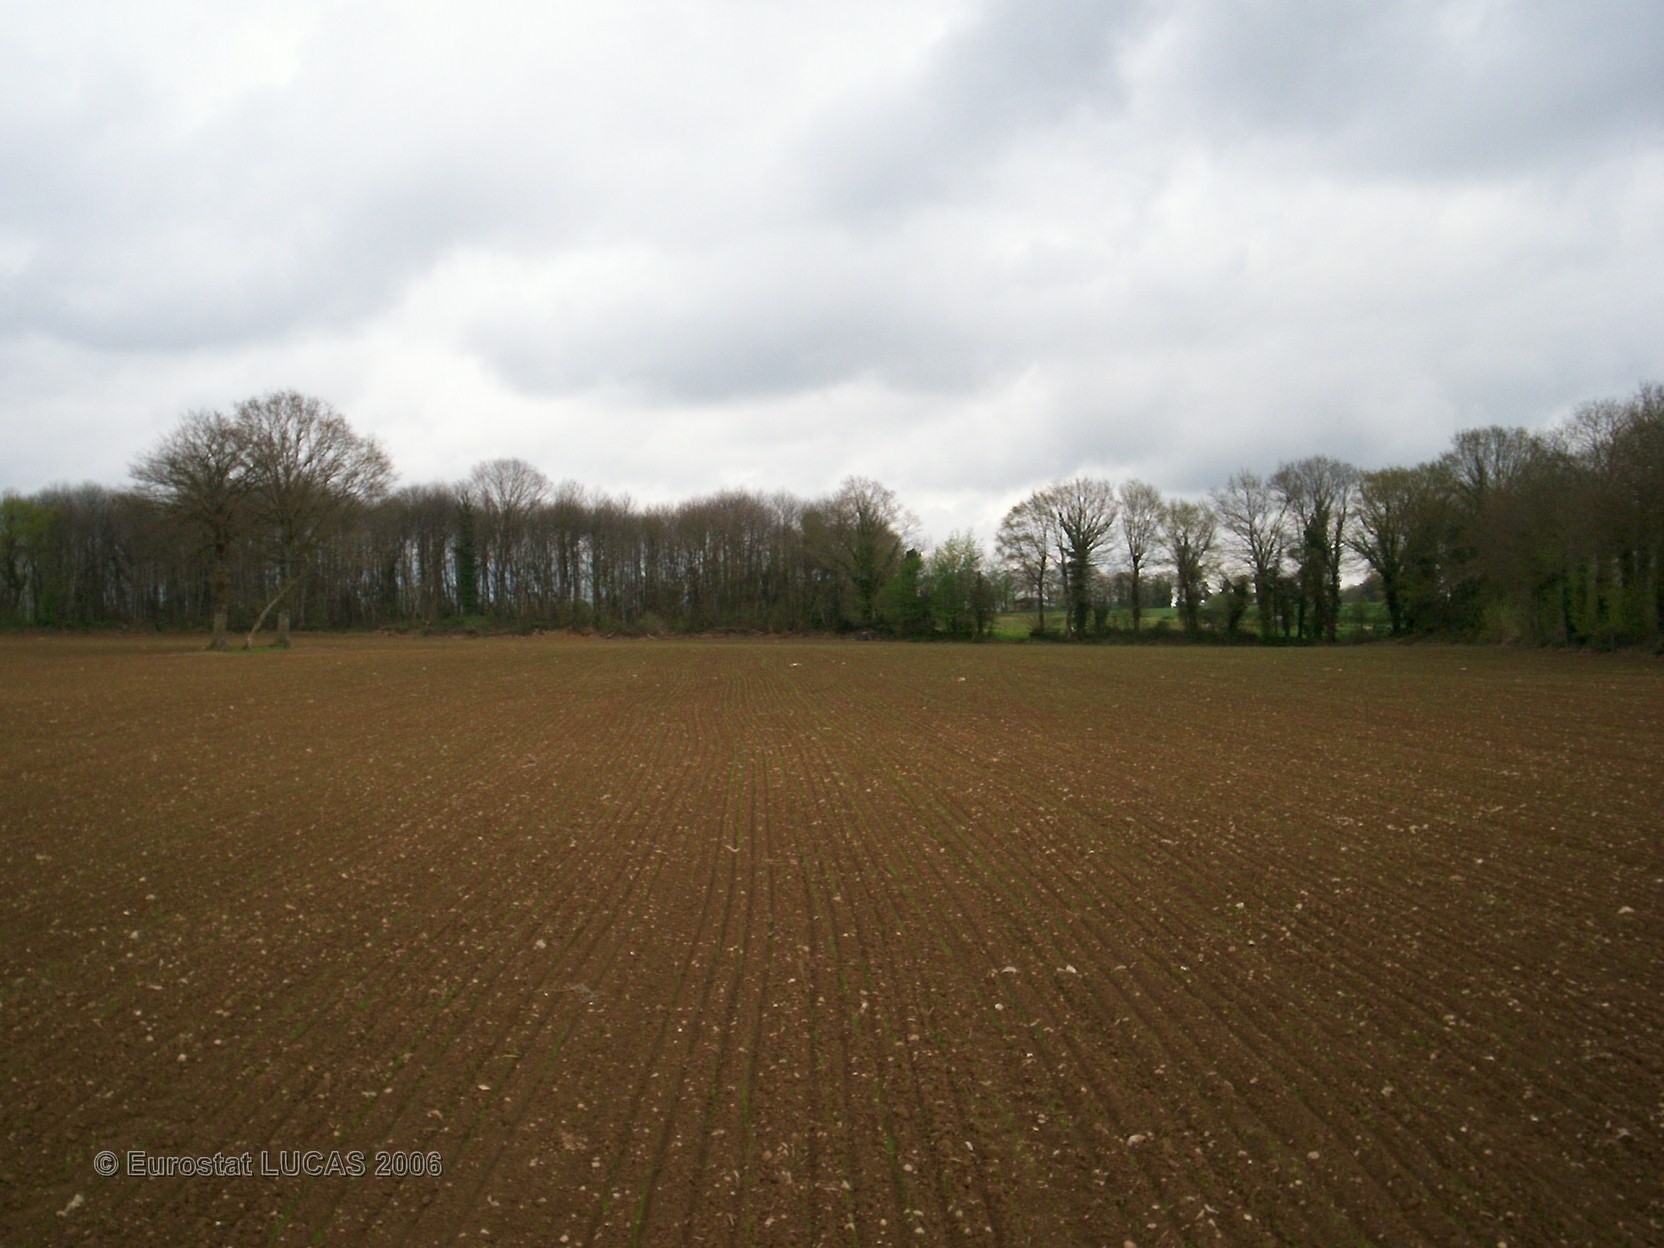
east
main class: Grassland
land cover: Grassland without tree/shrub cover
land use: Agriculture (excluding fallow land and kitchen gardens)
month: April
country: FR
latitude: 48.1028
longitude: -2.3999
